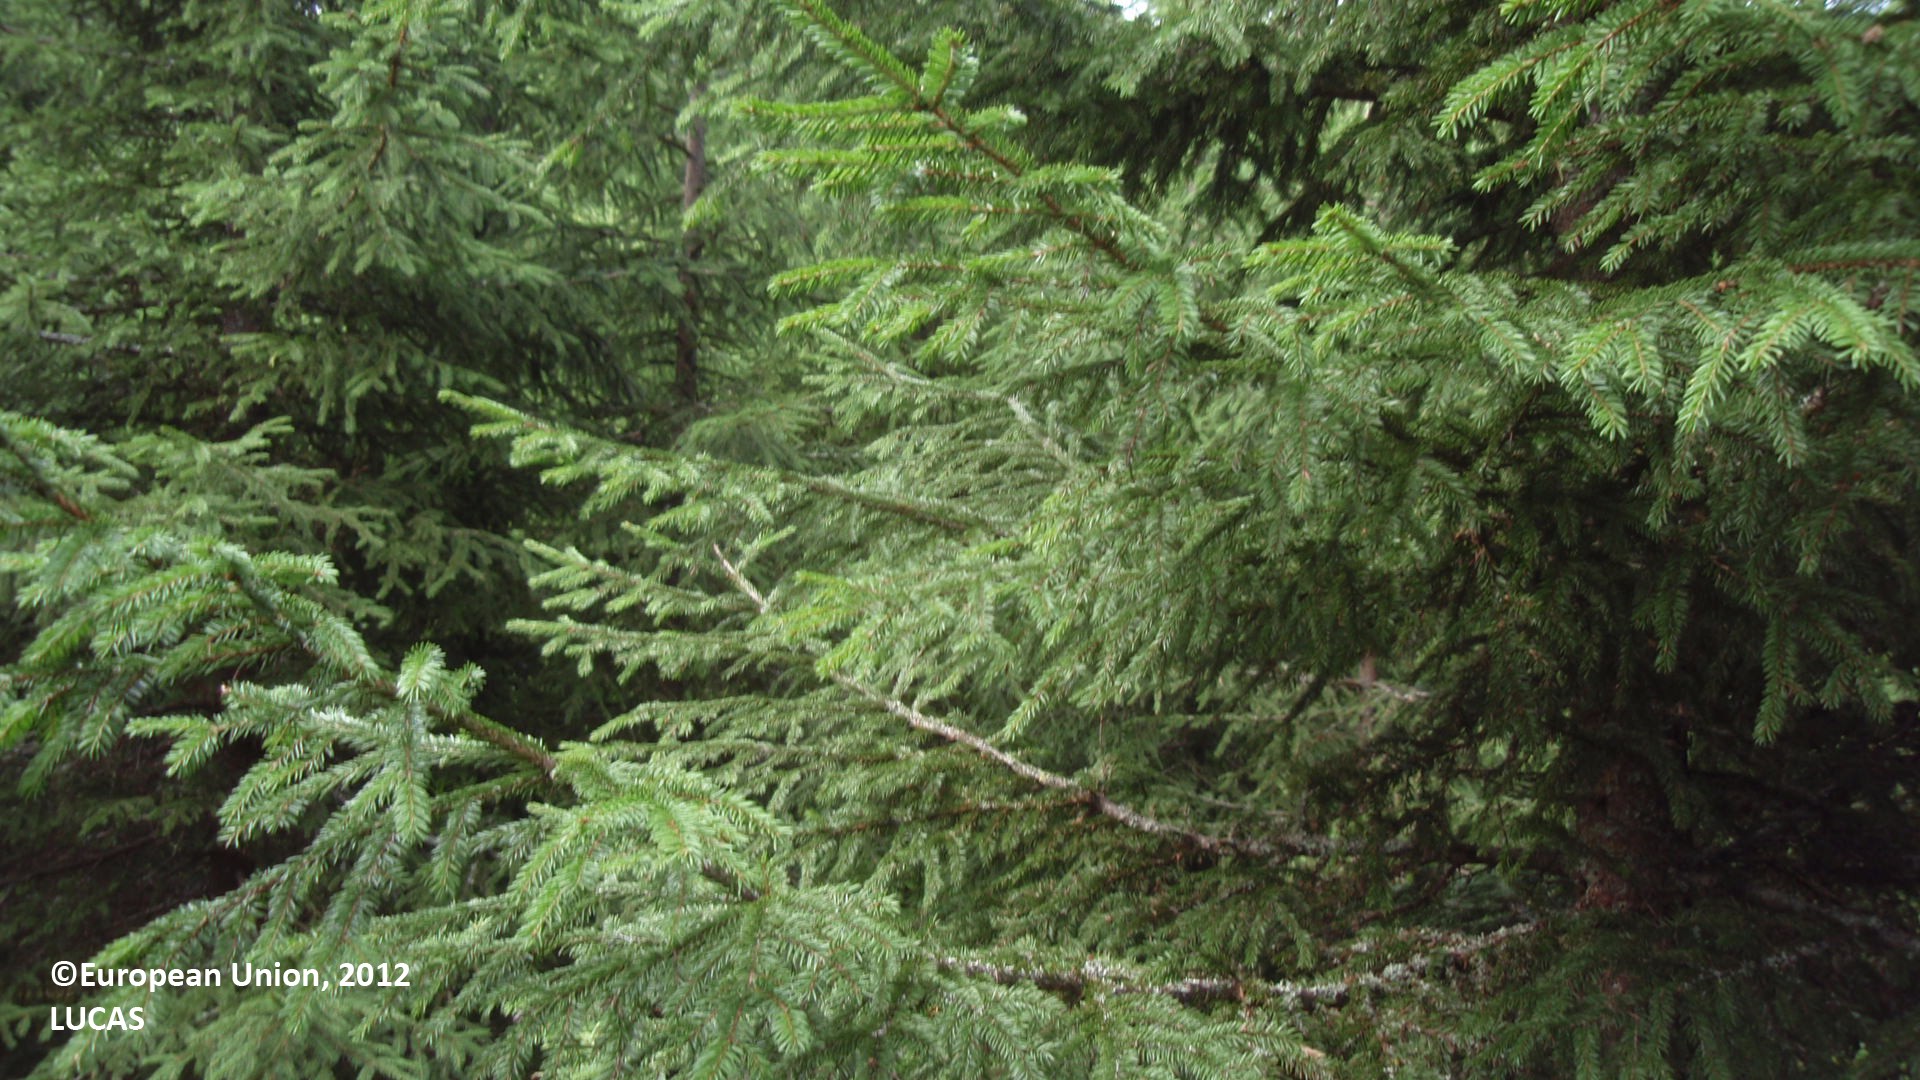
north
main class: Woodland
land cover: Spruce dominated coniferous woodland
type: boreal forest
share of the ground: > 75 %
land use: Forestry
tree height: > 5 m
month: August
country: FI
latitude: 61.0461
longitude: 26.9605
